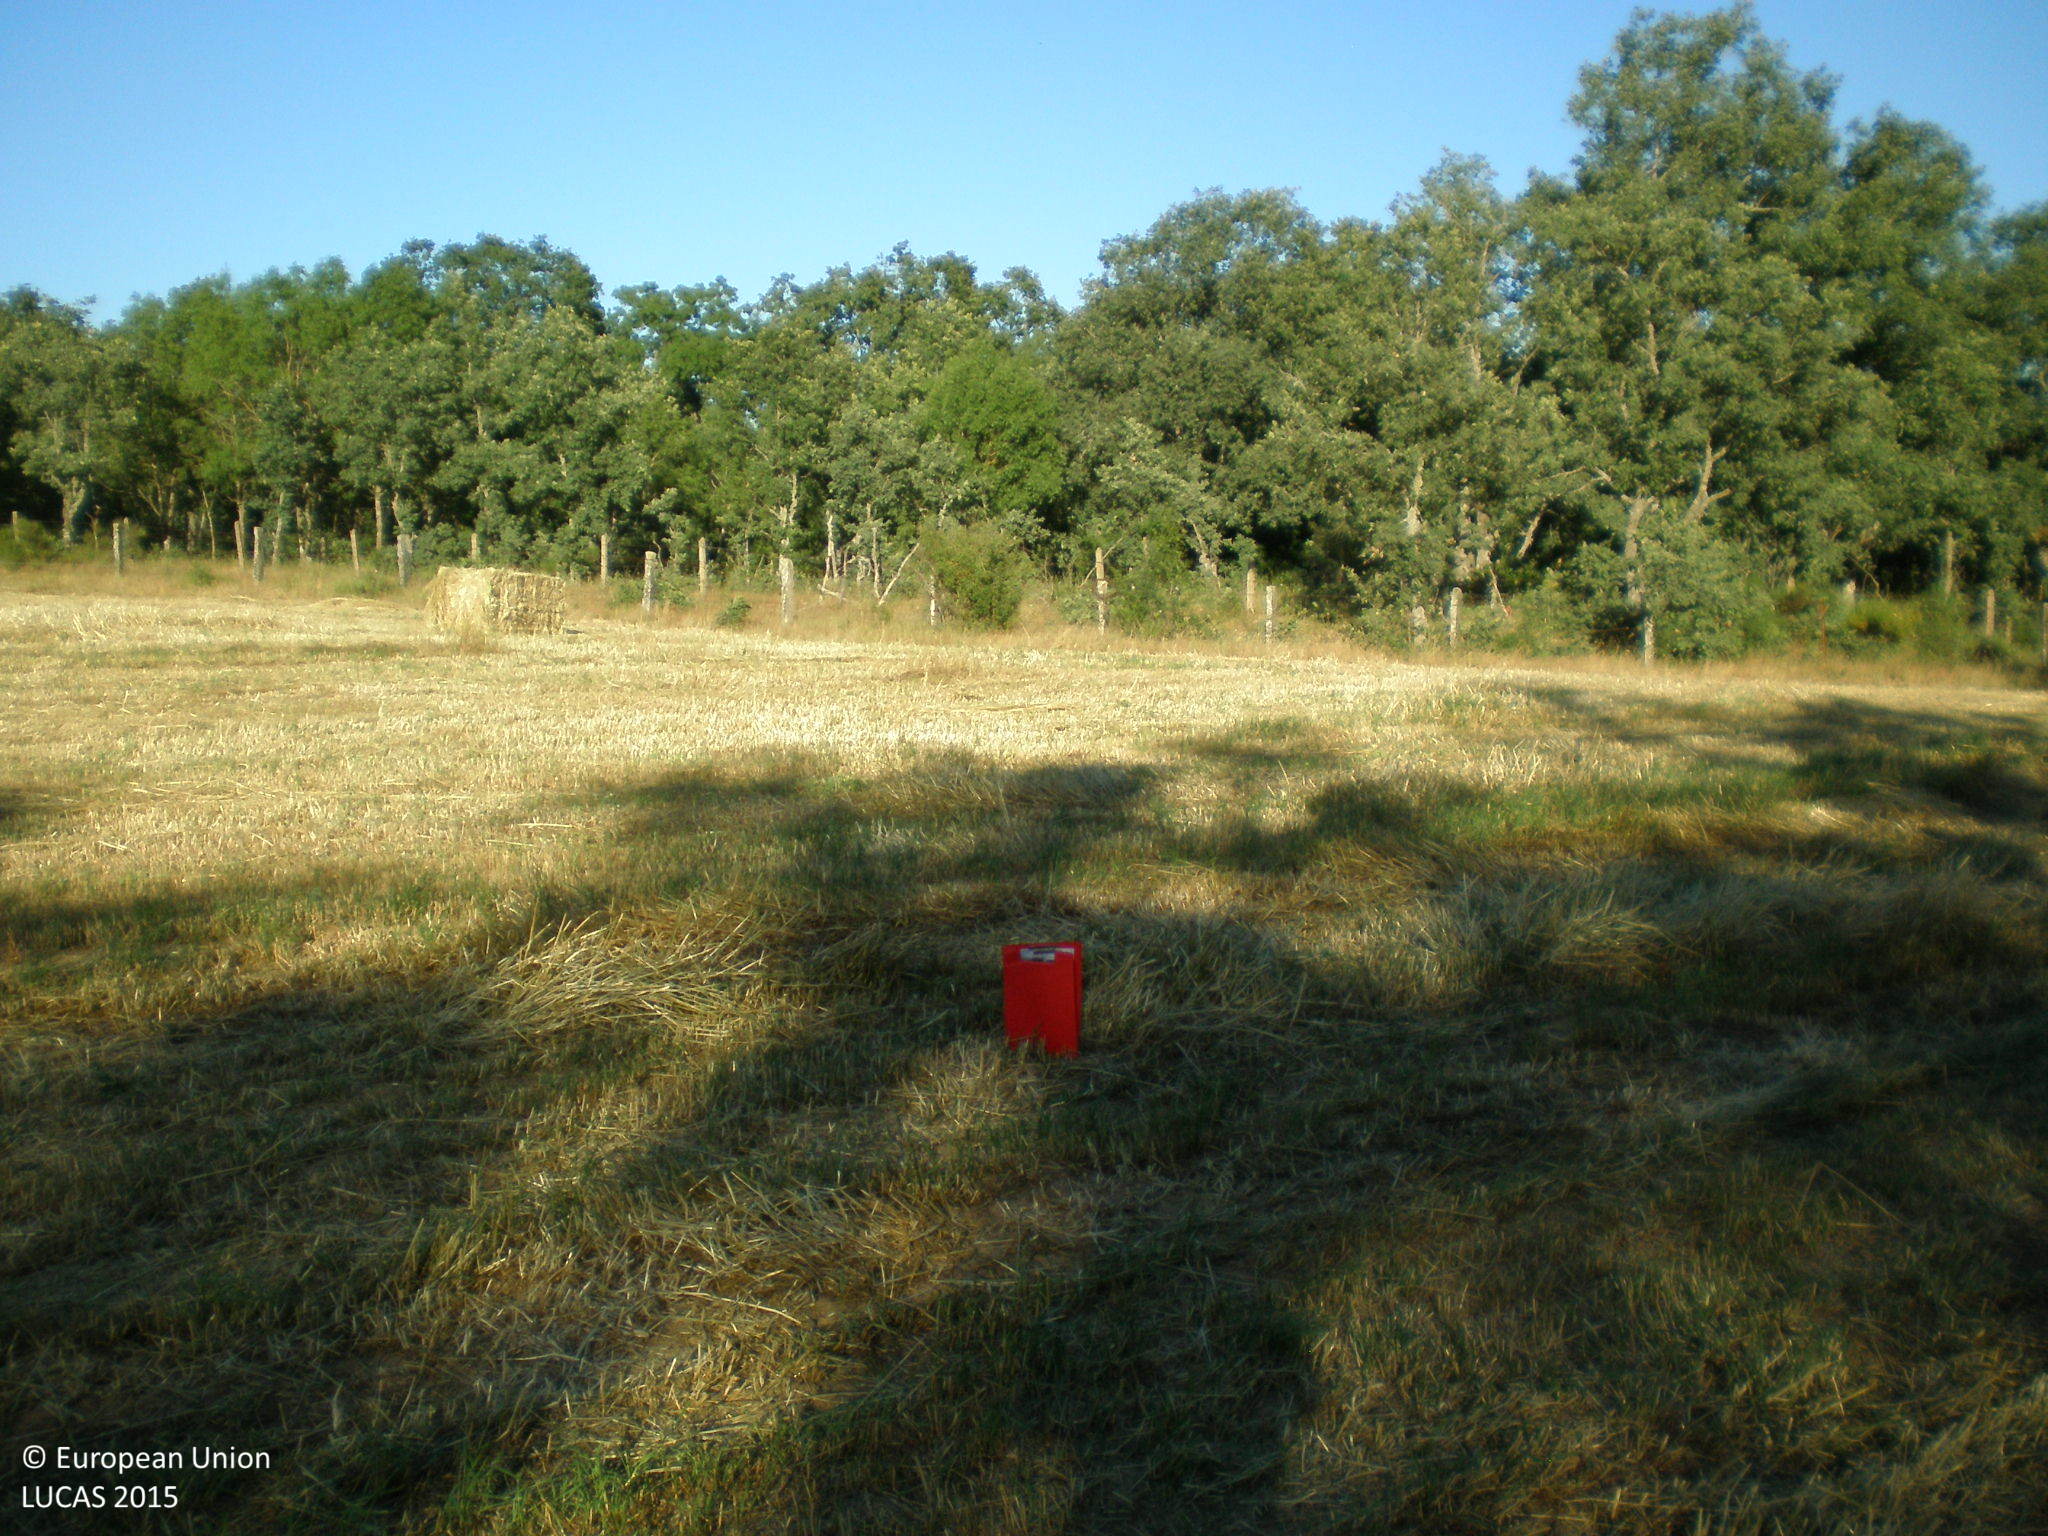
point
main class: Cropland
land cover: Mixed cereals for fodder
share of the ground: < 10 %
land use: Agriculture (excluding fallow land and kitchen gardens)
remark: Harvested field
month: June
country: ES
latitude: 40.5744
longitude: -5.8211
